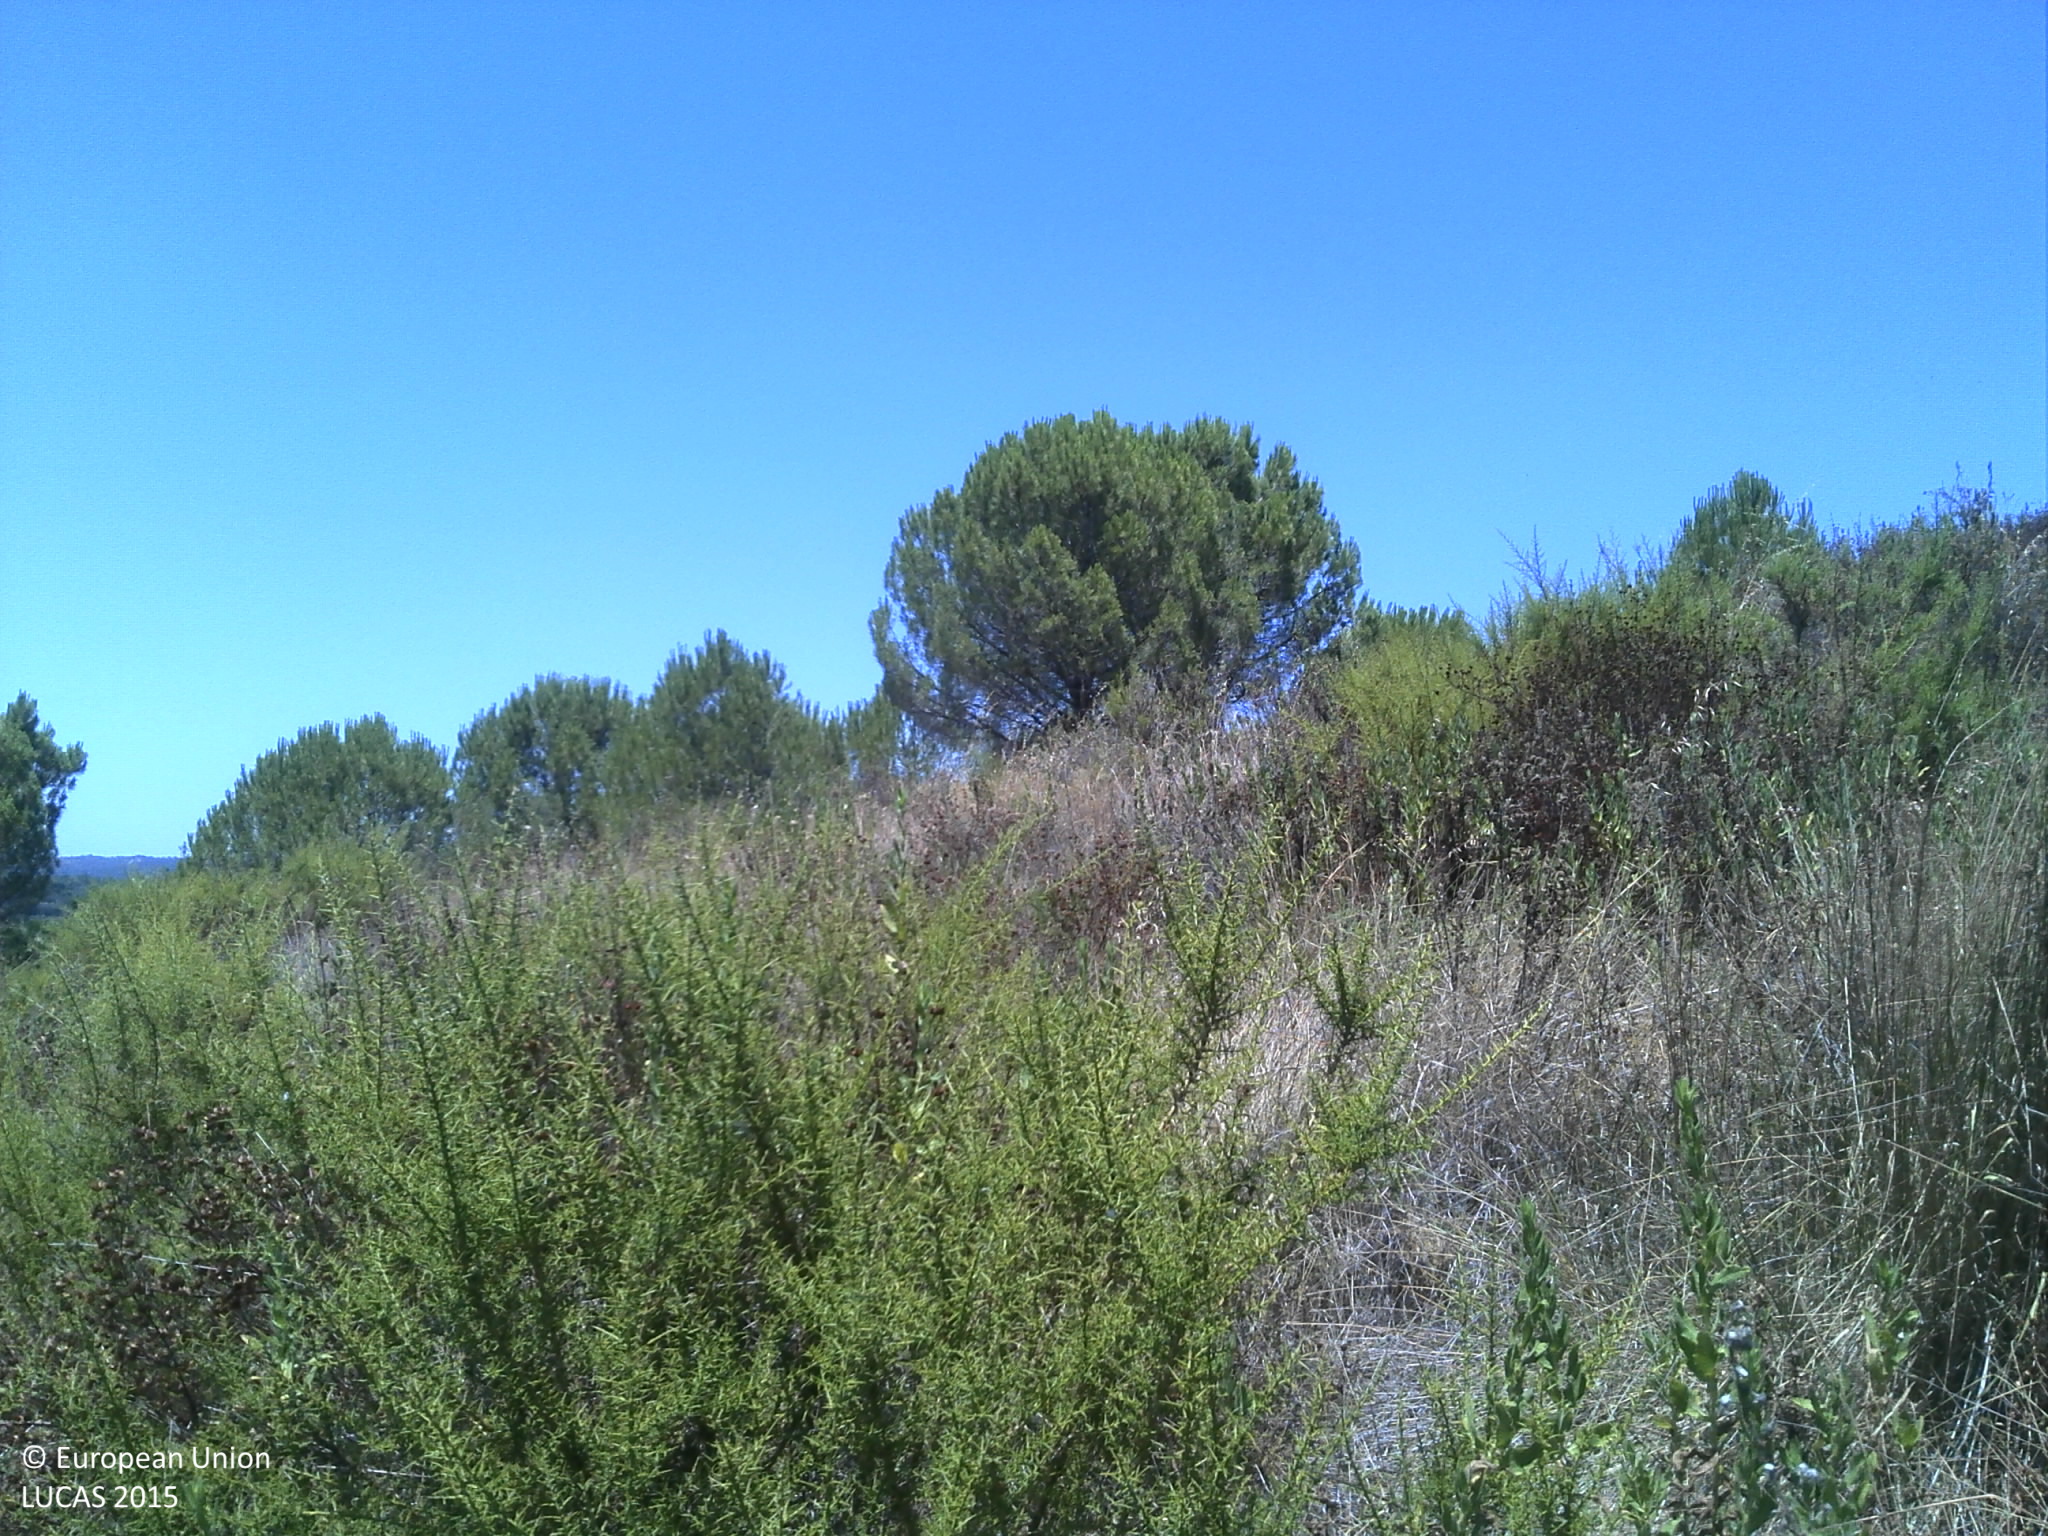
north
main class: Shrubland
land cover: Shrubland without tree cover
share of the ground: 50 - 75 %
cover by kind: shrubs 50 %, unconsolidated bare surface 40 %, herbaceous plants 10 %
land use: Forestry
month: July
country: PT
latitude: 39.0247
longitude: -8.2254
